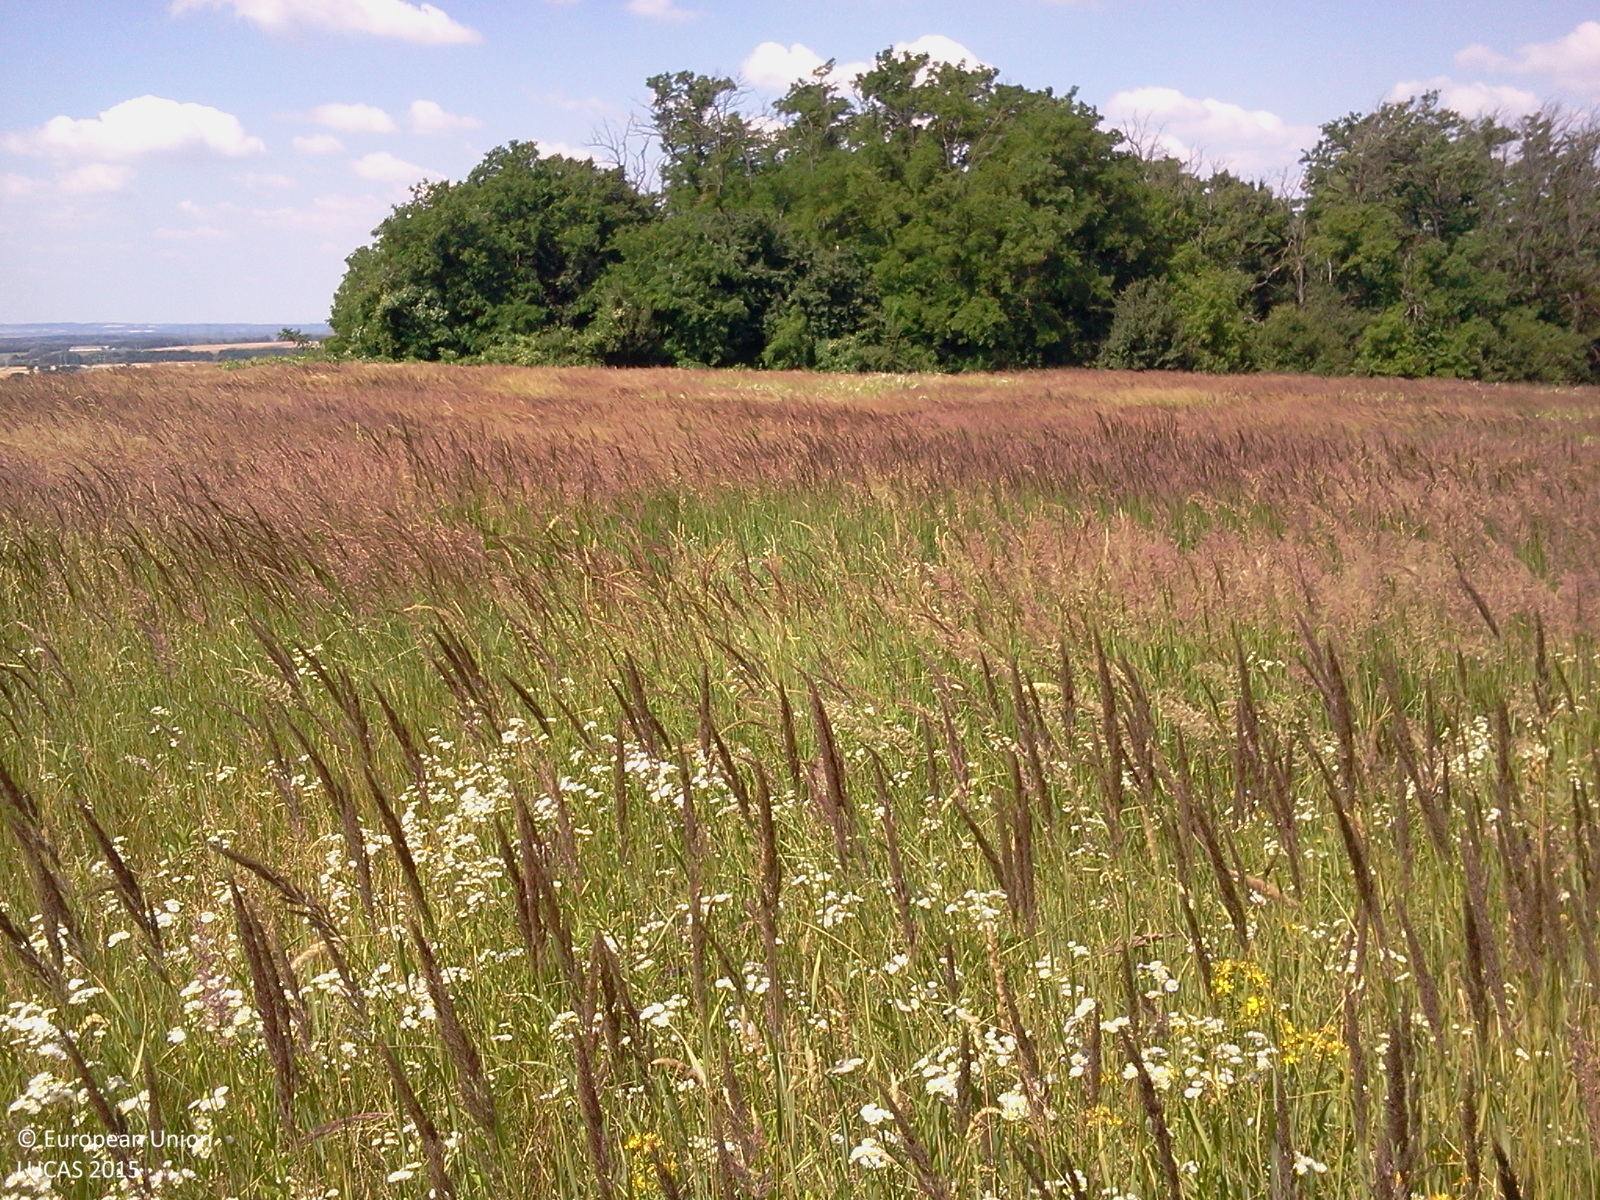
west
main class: Grassland
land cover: Grassland without tree/shrub cover
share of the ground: > 75 %
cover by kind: herbaceous plants 100 %
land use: Agriculture (excluding fallow land and kitchen gardens)
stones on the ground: < 10 %
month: June
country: HU
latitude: 46.7667
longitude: 17.0880
